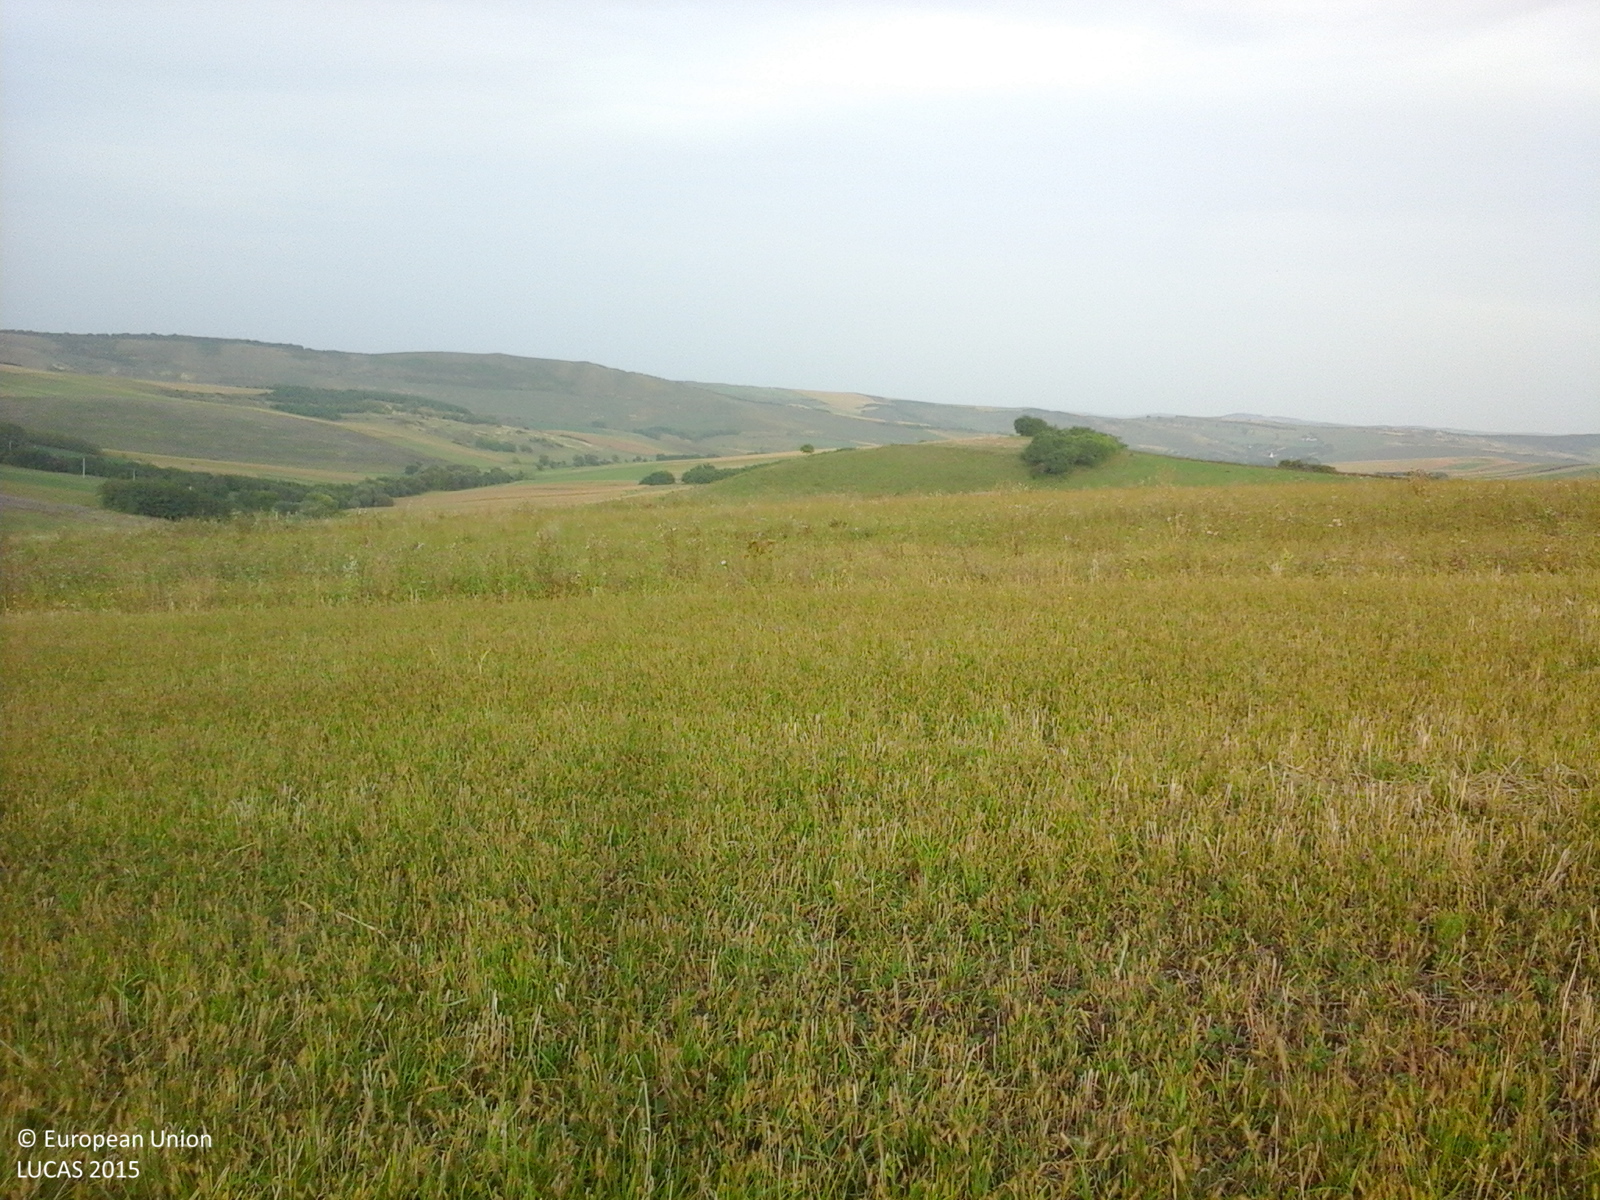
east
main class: Grassland
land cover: Spontaneously vegetated surfaces
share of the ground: > 75 %
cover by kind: herbaceous plants 100 %
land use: Fallow land
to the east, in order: Spontaneously vegetated surfaces; Grassland without tree/shrub cover; Tracks; Grassland without tree/shrub cover
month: September
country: RO
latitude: 46.7699
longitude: 24.0522
